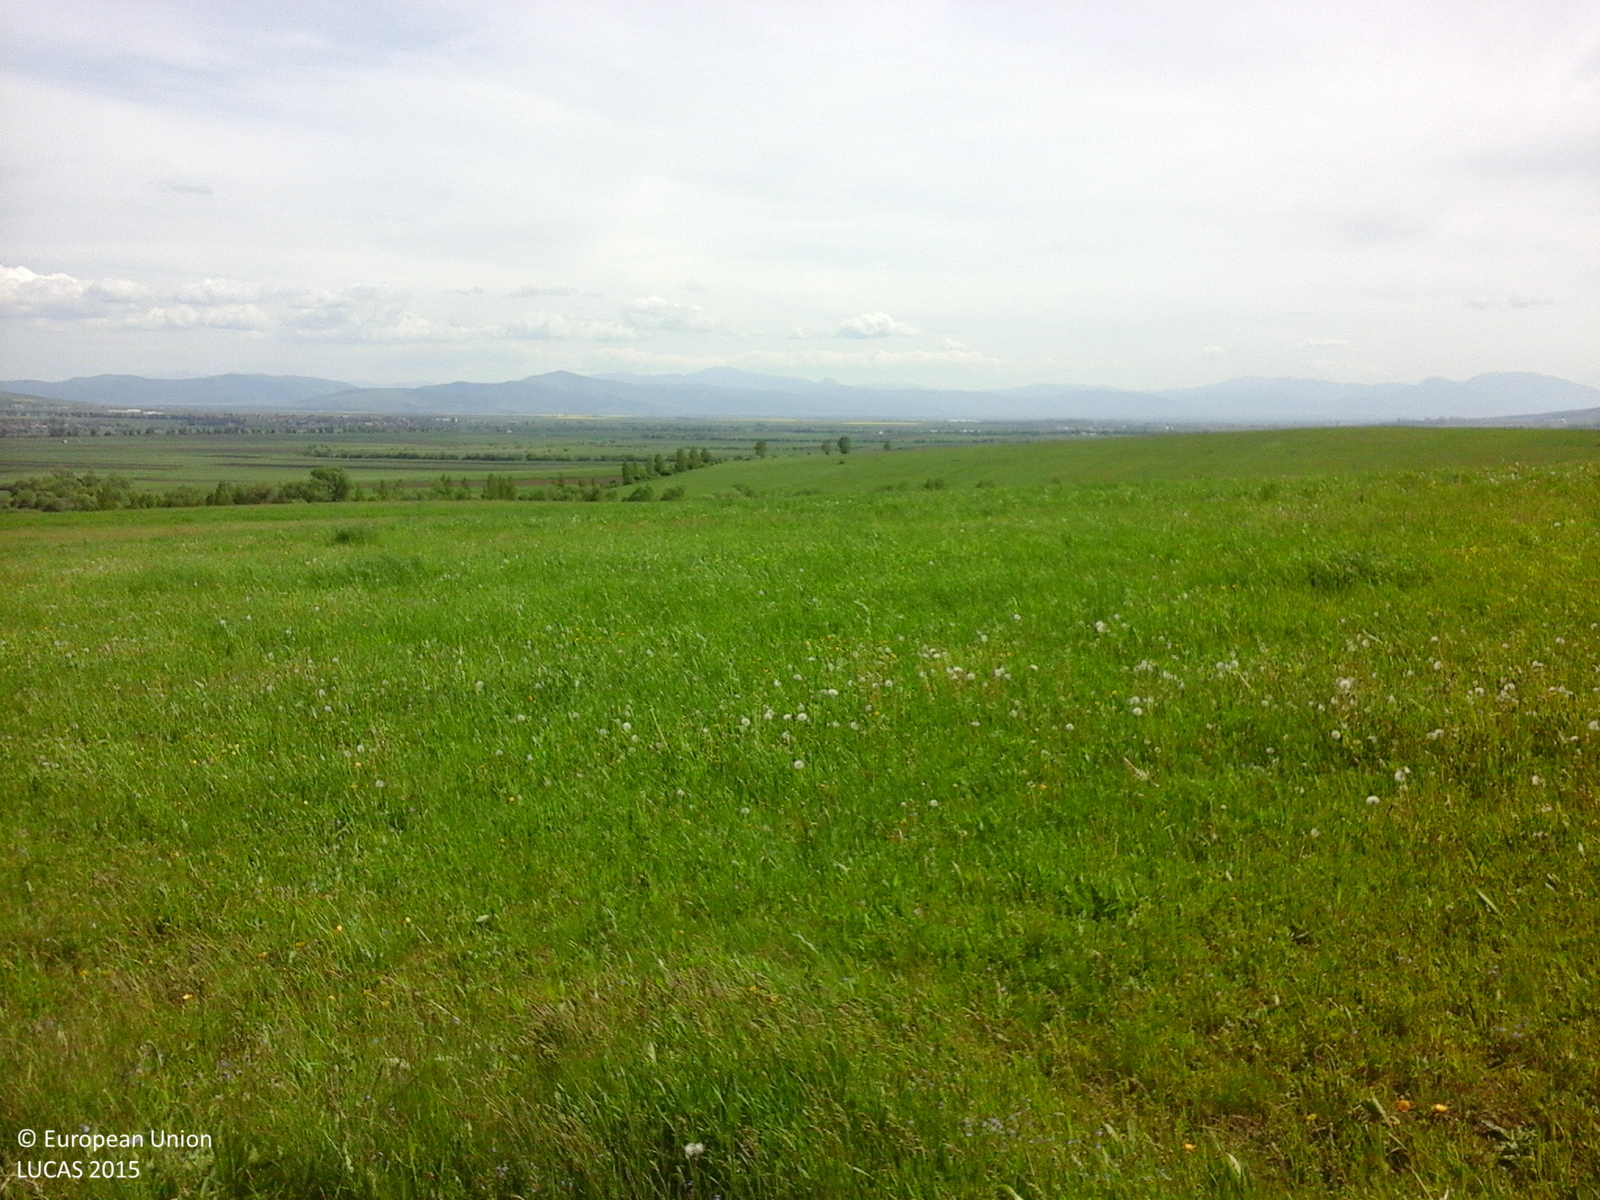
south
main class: Grassland
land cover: Grassland without tree/shrub cover
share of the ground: > 75 %
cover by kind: herbaceous plants 100 %
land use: Agriculture (excluding fallow land and kitchen gardens)
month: May
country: RO
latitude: 45.9541
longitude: 25.8135
